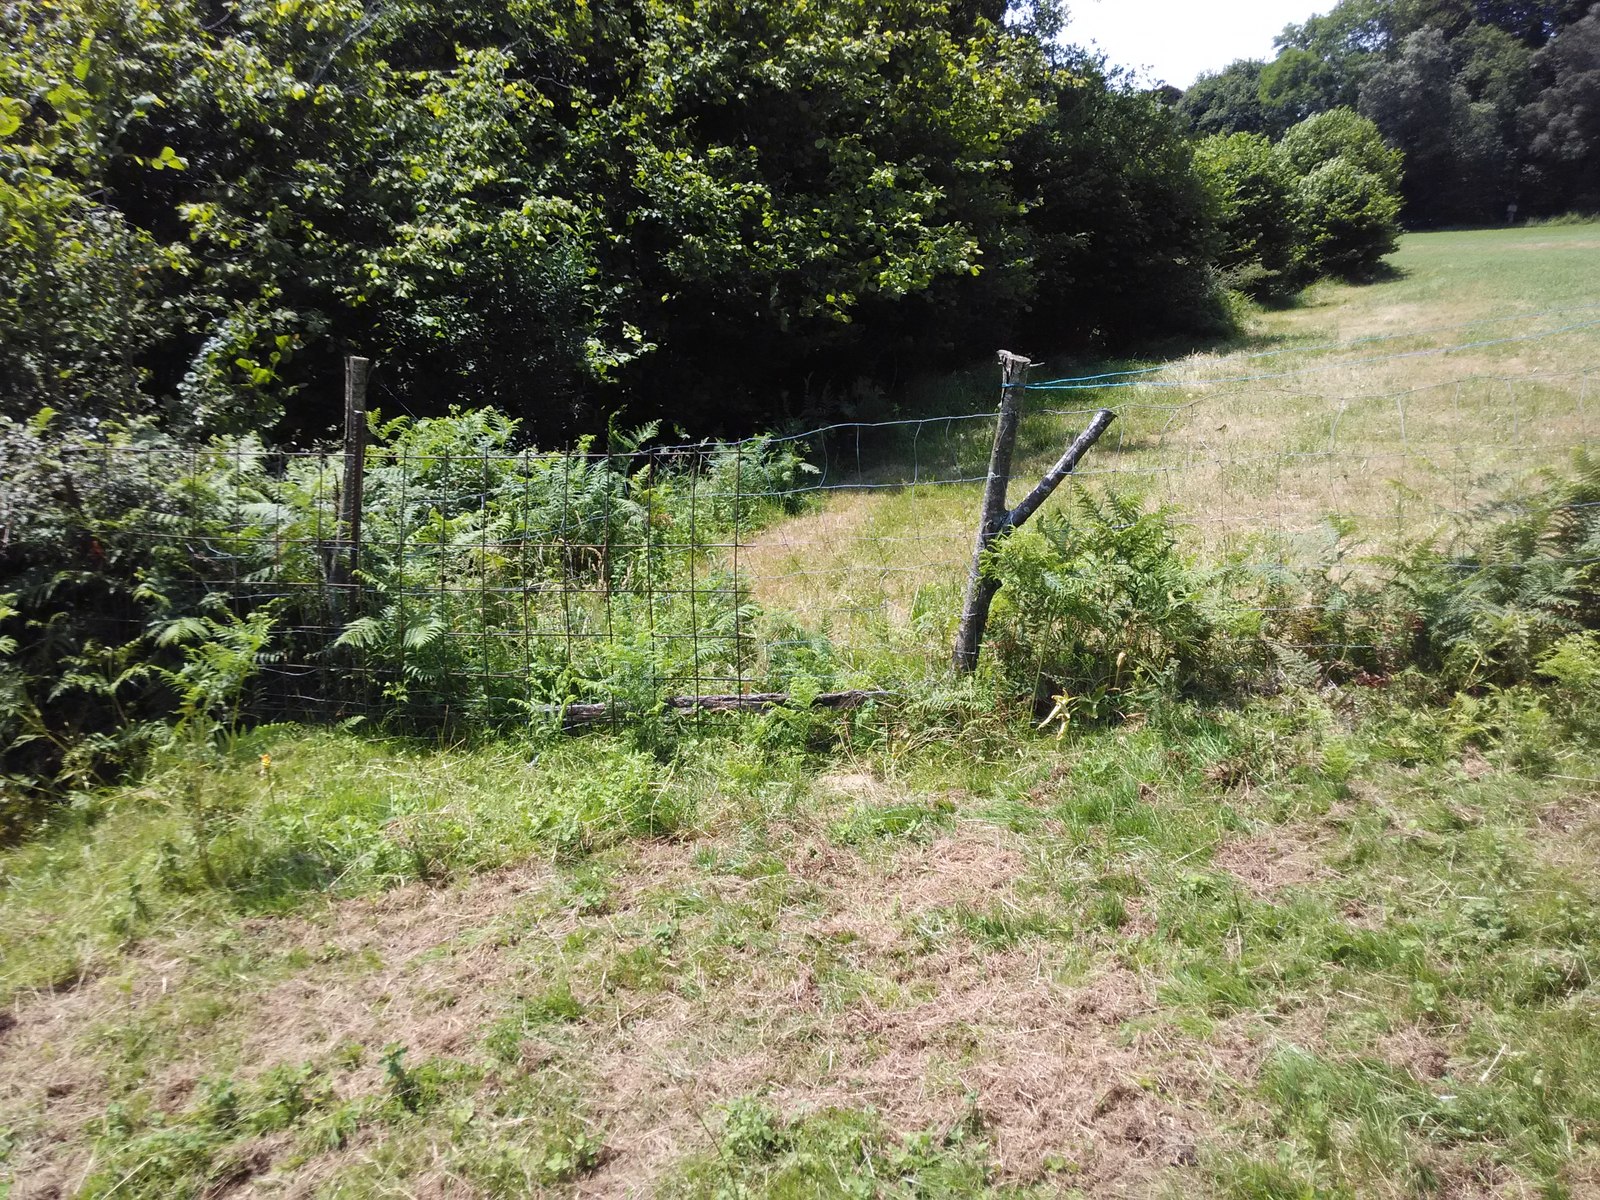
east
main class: Grassland
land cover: Grassland without tree/shrub cover
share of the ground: > 75 %
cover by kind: herbaceous plants 100 %
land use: Agriculture (excluding fallow land and kitchen gardens)
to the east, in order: Grassland without tree/shrub cover; Fences; Grassland with sparse tree/shrub cover; Broadleaved woodland; Artificial constructions in urban areas; Tracks; Broadleaved woodland
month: July
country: ES
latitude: 43.1852
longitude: -2.2421
